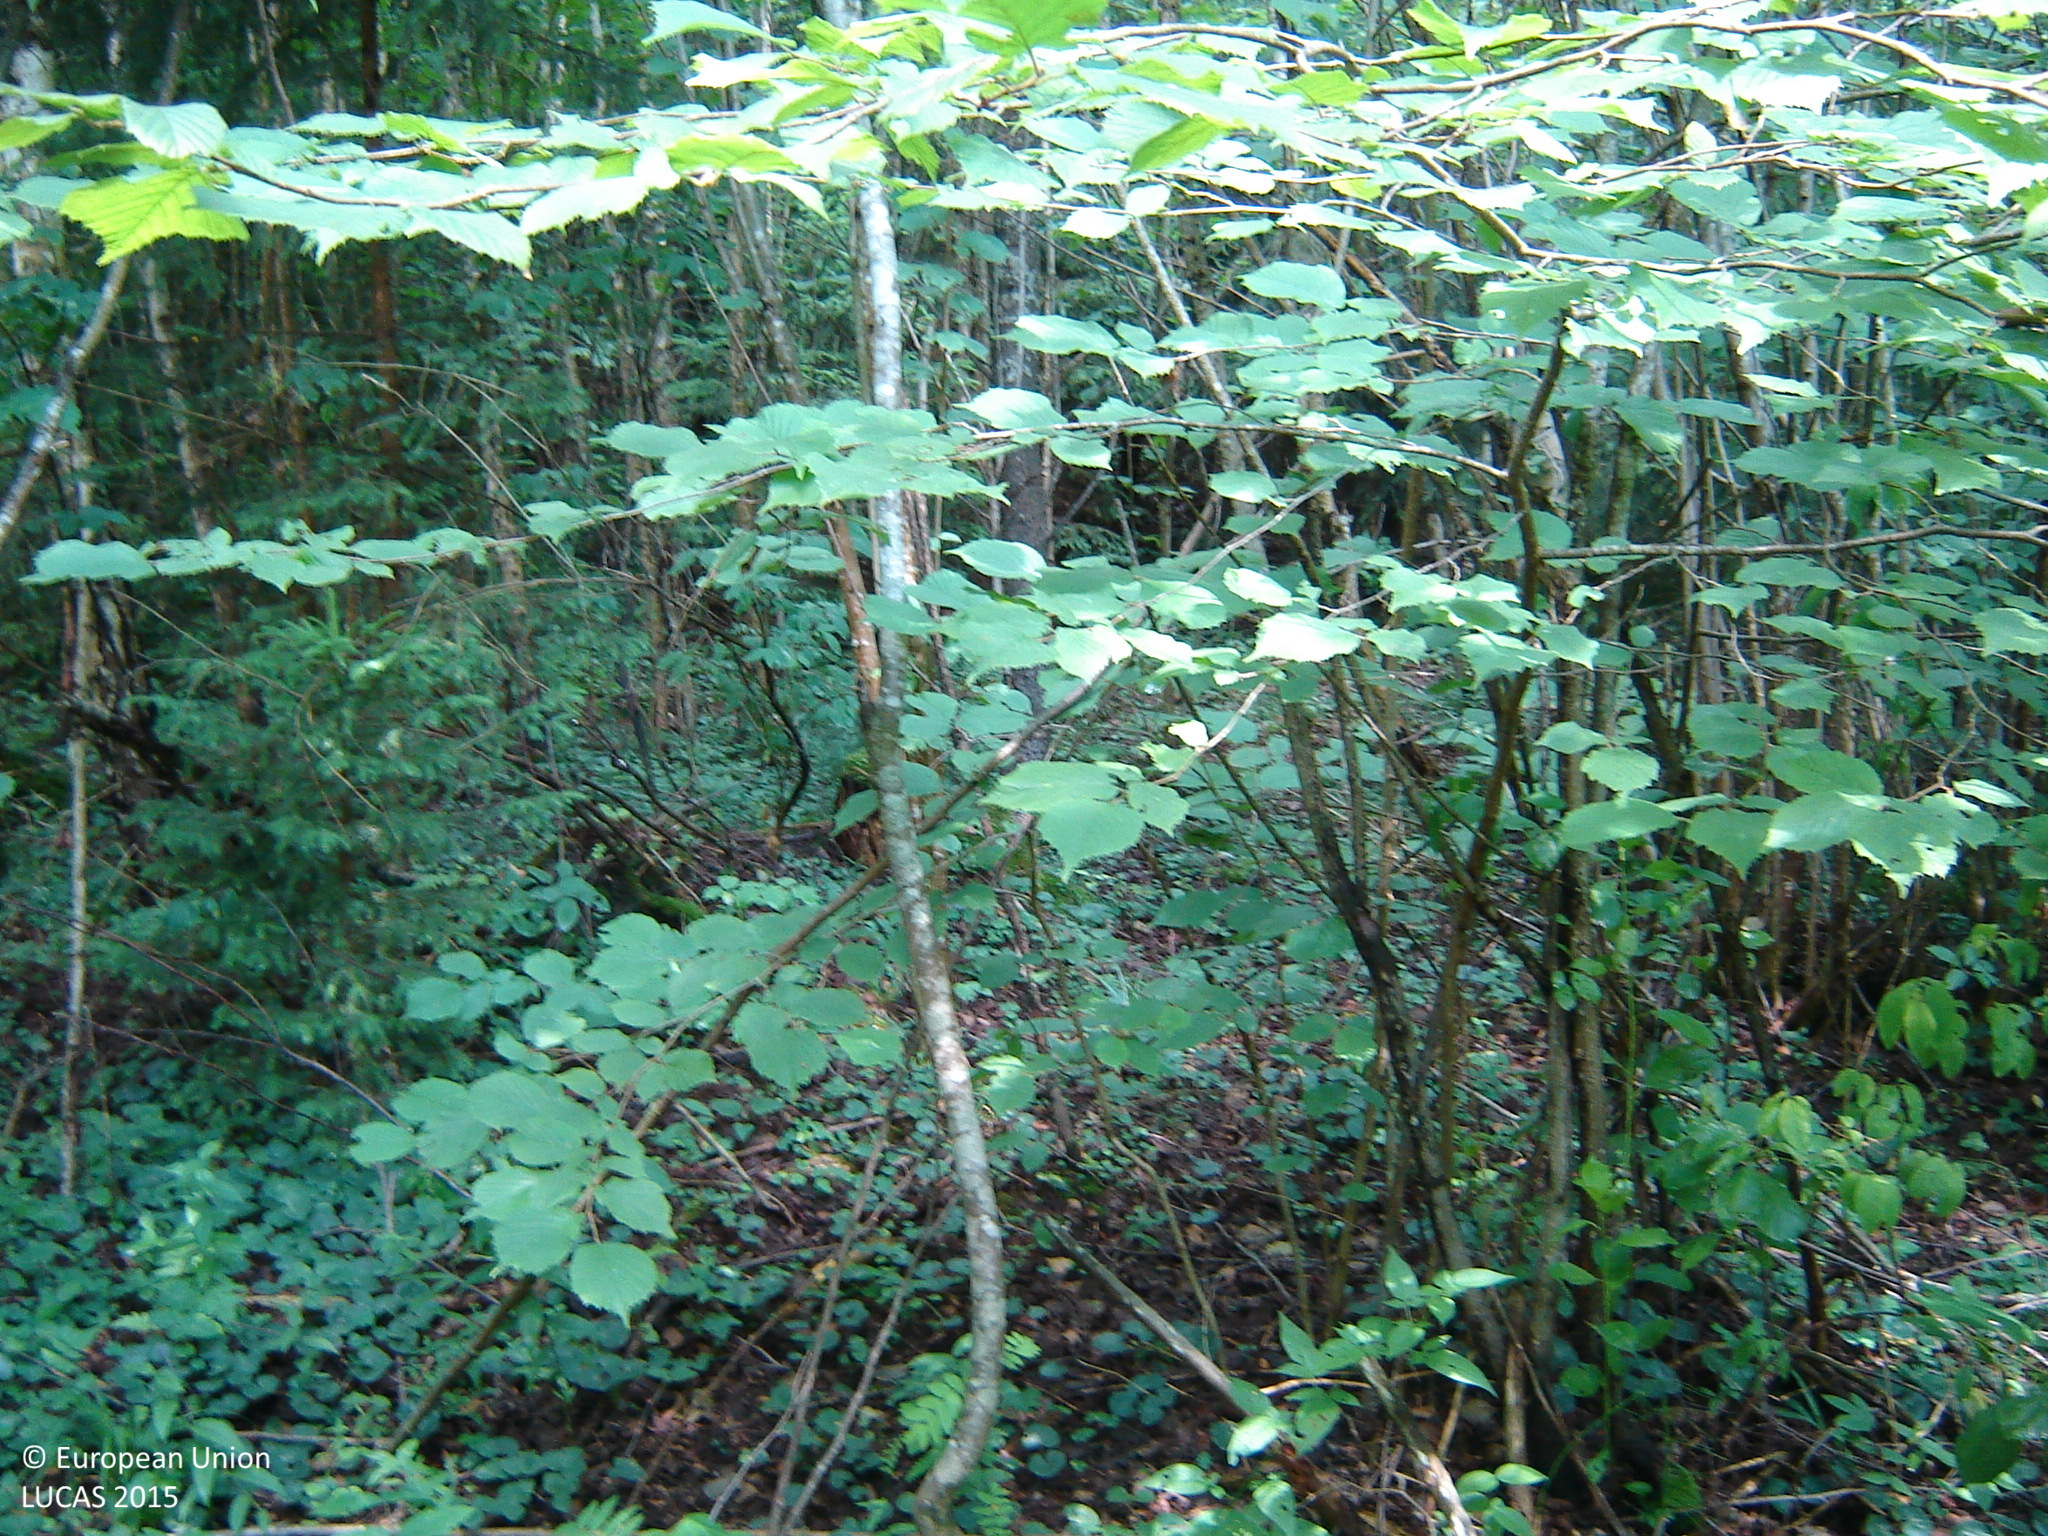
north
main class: Woodland
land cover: Broadleaved woodland
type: mire and swamp forests
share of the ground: > 75 %
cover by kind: broadleaved forest trees 80 %, herbaceous plants 20 %
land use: Forestry
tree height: > 5 m
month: July
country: LT
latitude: 55.4243
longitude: 25.1741
